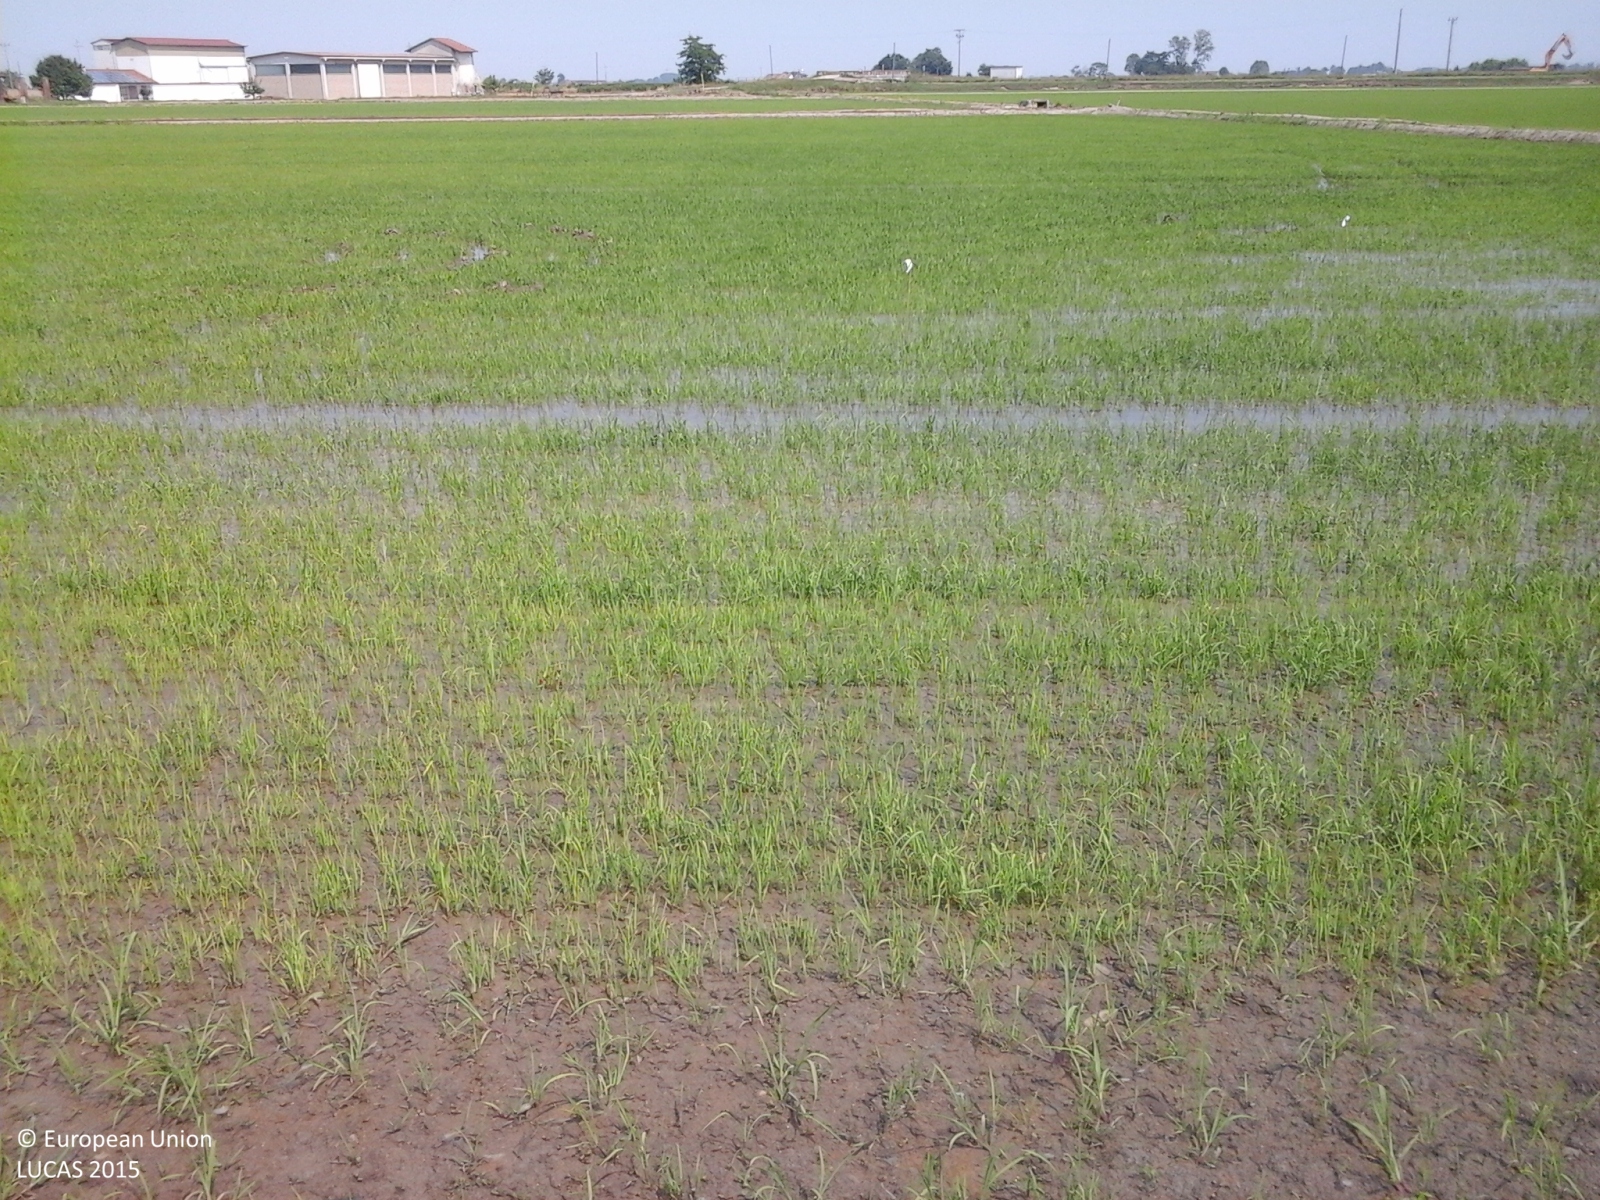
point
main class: Cropland
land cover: Rice
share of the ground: 25 - 50 %
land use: Agriculture (excluding fallow land and kitchen gardens)
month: May
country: IT
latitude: 45.3634
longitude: 8.2284
